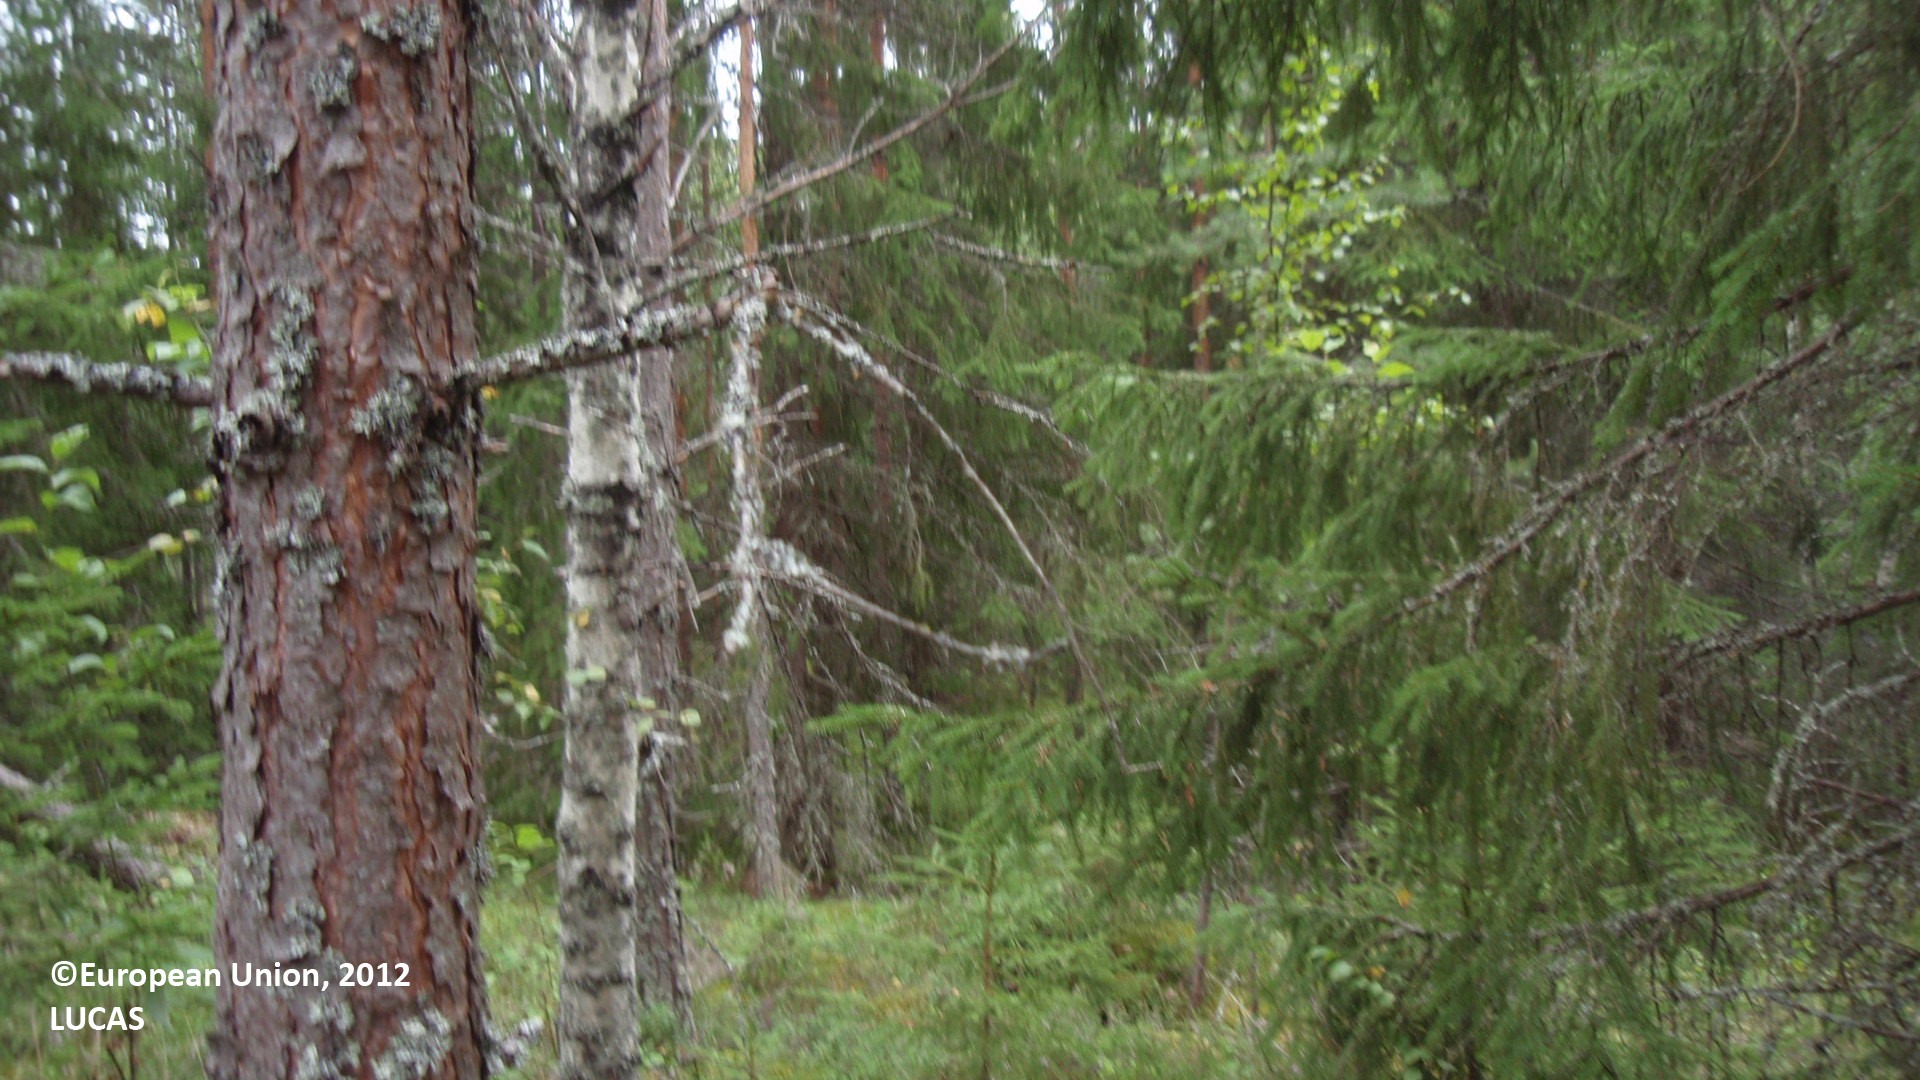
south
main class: Woodland
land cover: Other coniferous woodland
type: boreal forest
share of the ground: 50 - 75 %
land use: Forestry
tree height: > 5 m
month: August
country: FI
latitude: 61.1237
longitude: 27.6924
